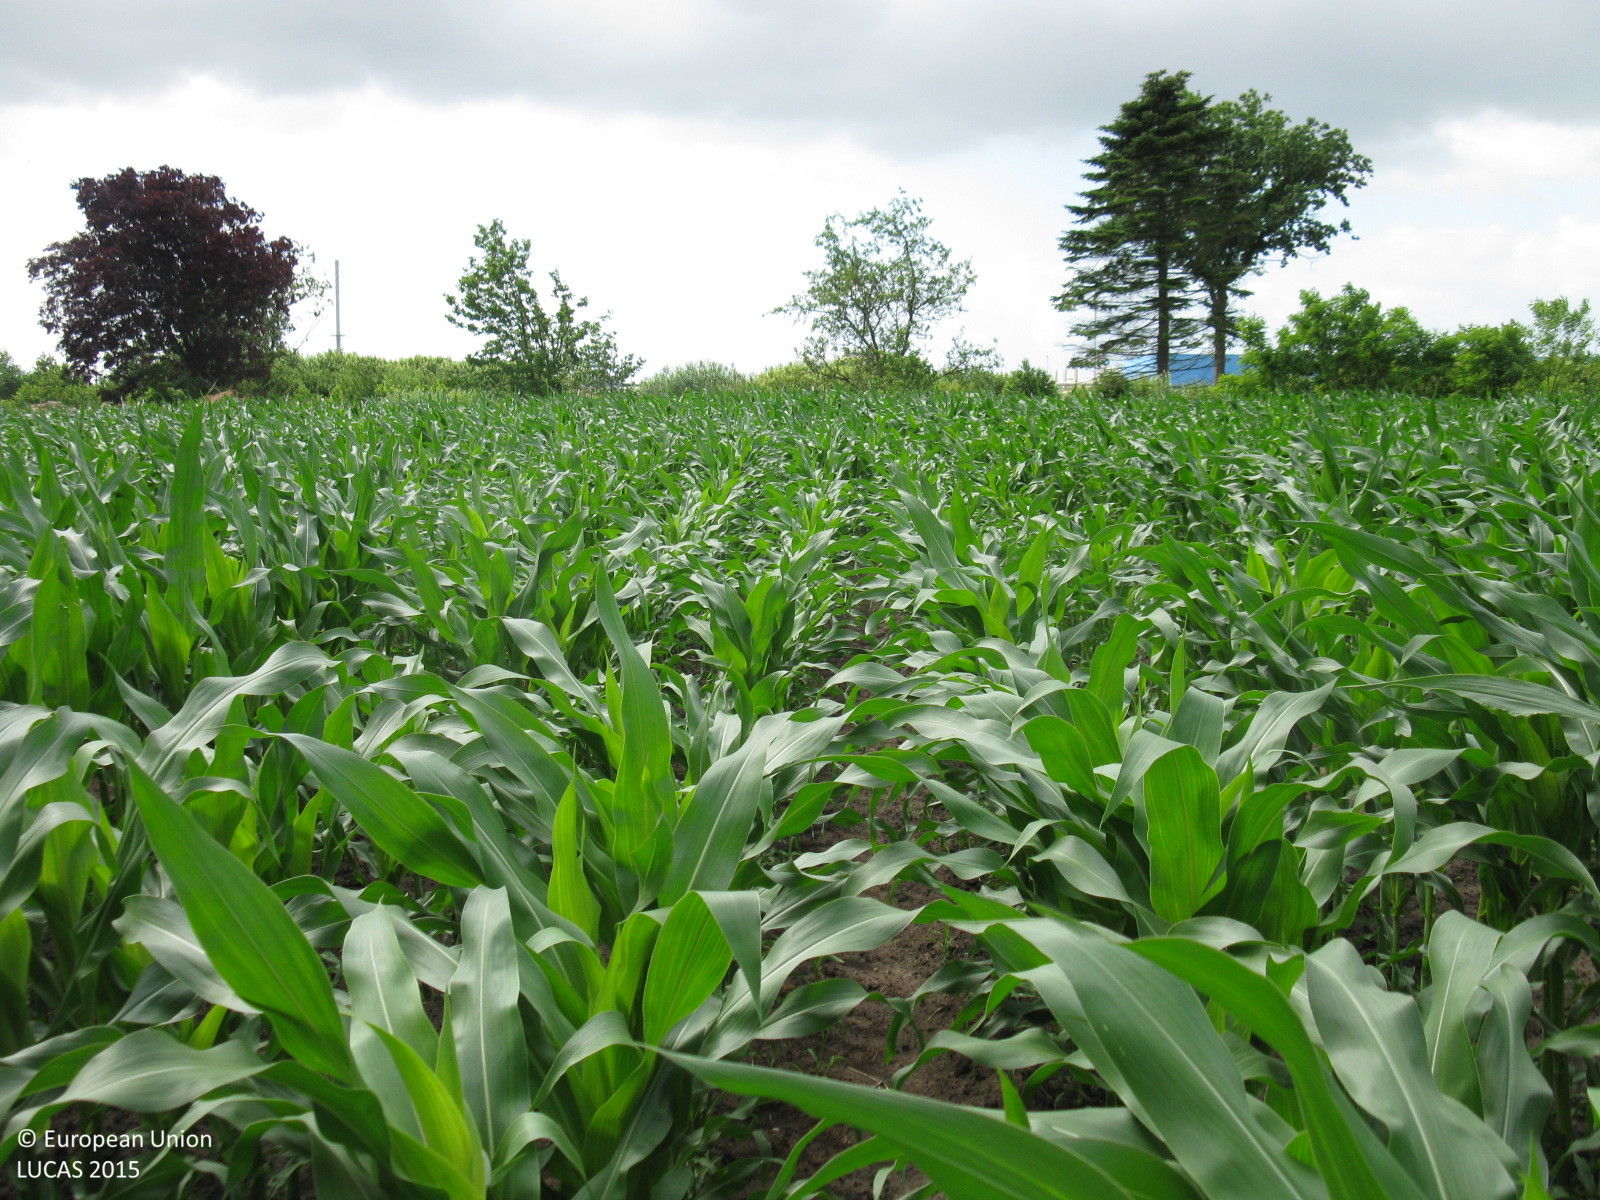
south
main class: Cropland
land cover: Maize
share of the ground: > 75 %
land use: Agriculture (excluding fallow land and kitchen gardens)
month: July
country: DE
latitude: 53.4558
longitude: 7.9074
